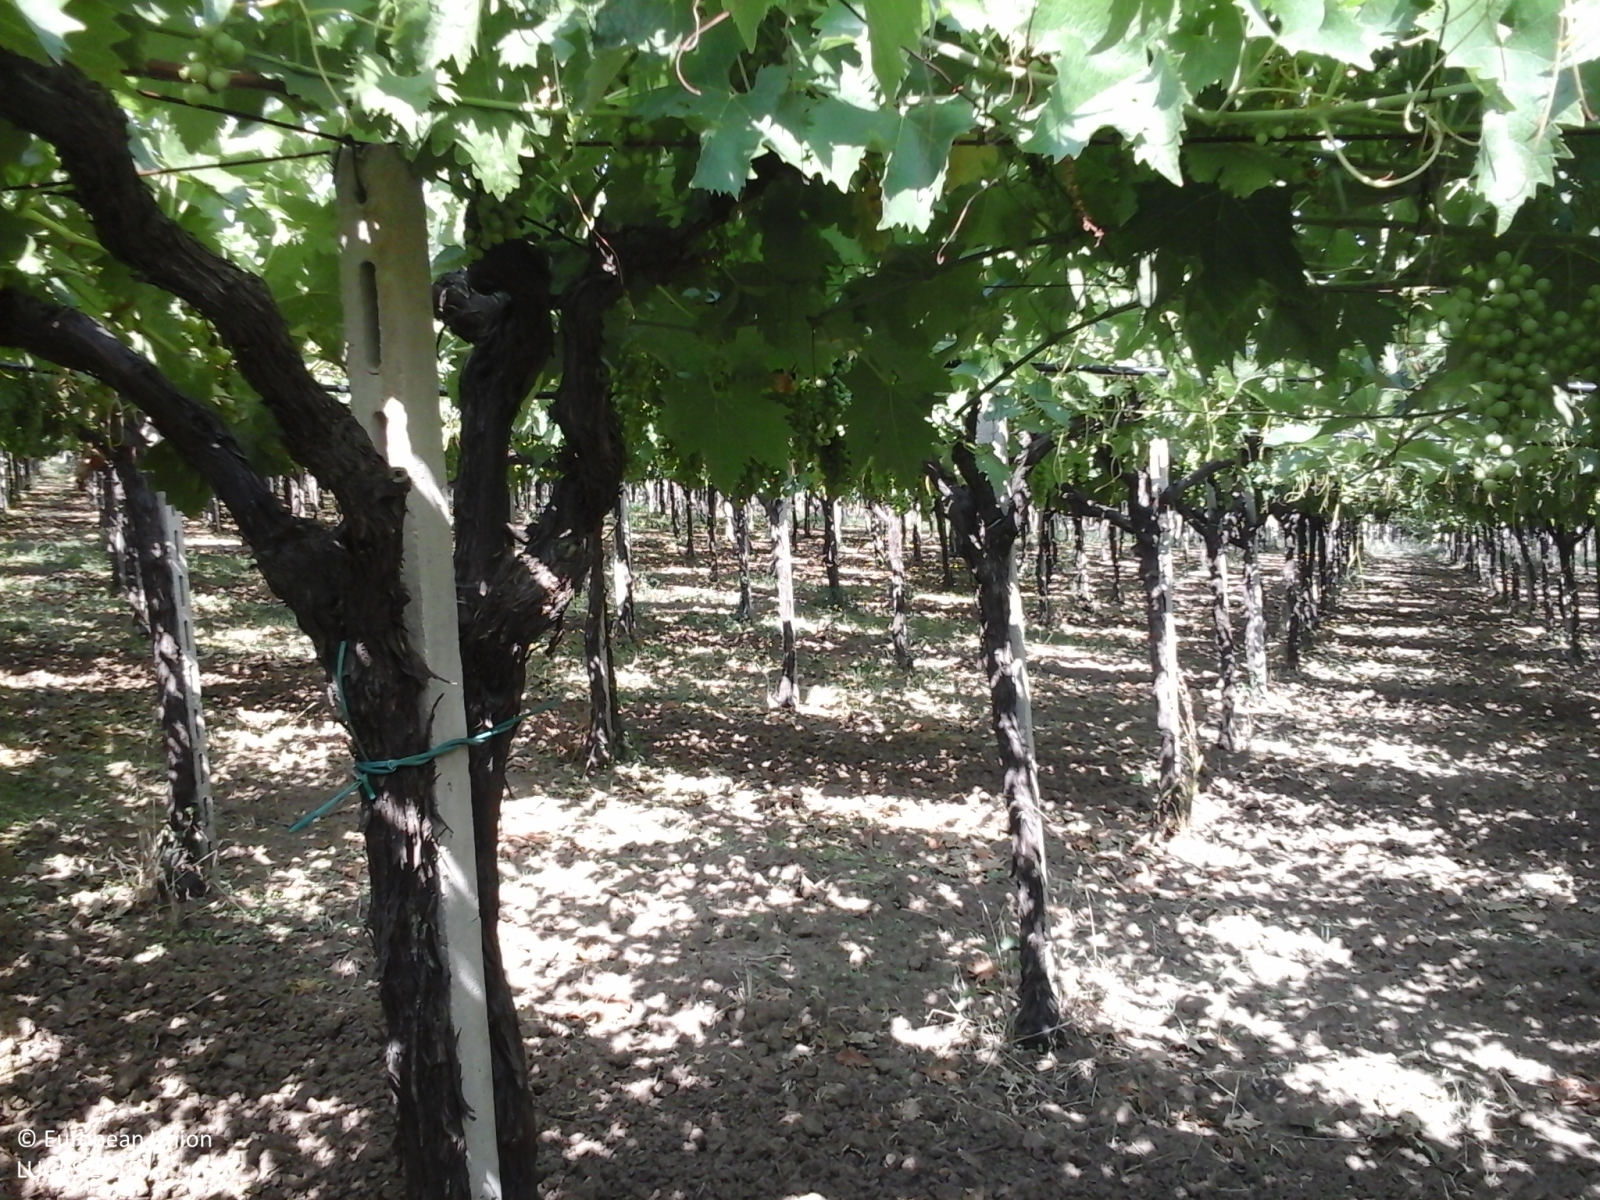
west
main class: Cropland
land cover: Vineyards
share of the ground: 25 - 50 %
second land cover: Spontaneously vegetated surfaces
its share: 25 - 50 %
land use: Agriculture (excluding fallow land and kitchen gardens)
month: July
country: IT
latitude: 42.3629
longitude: 14.3218
